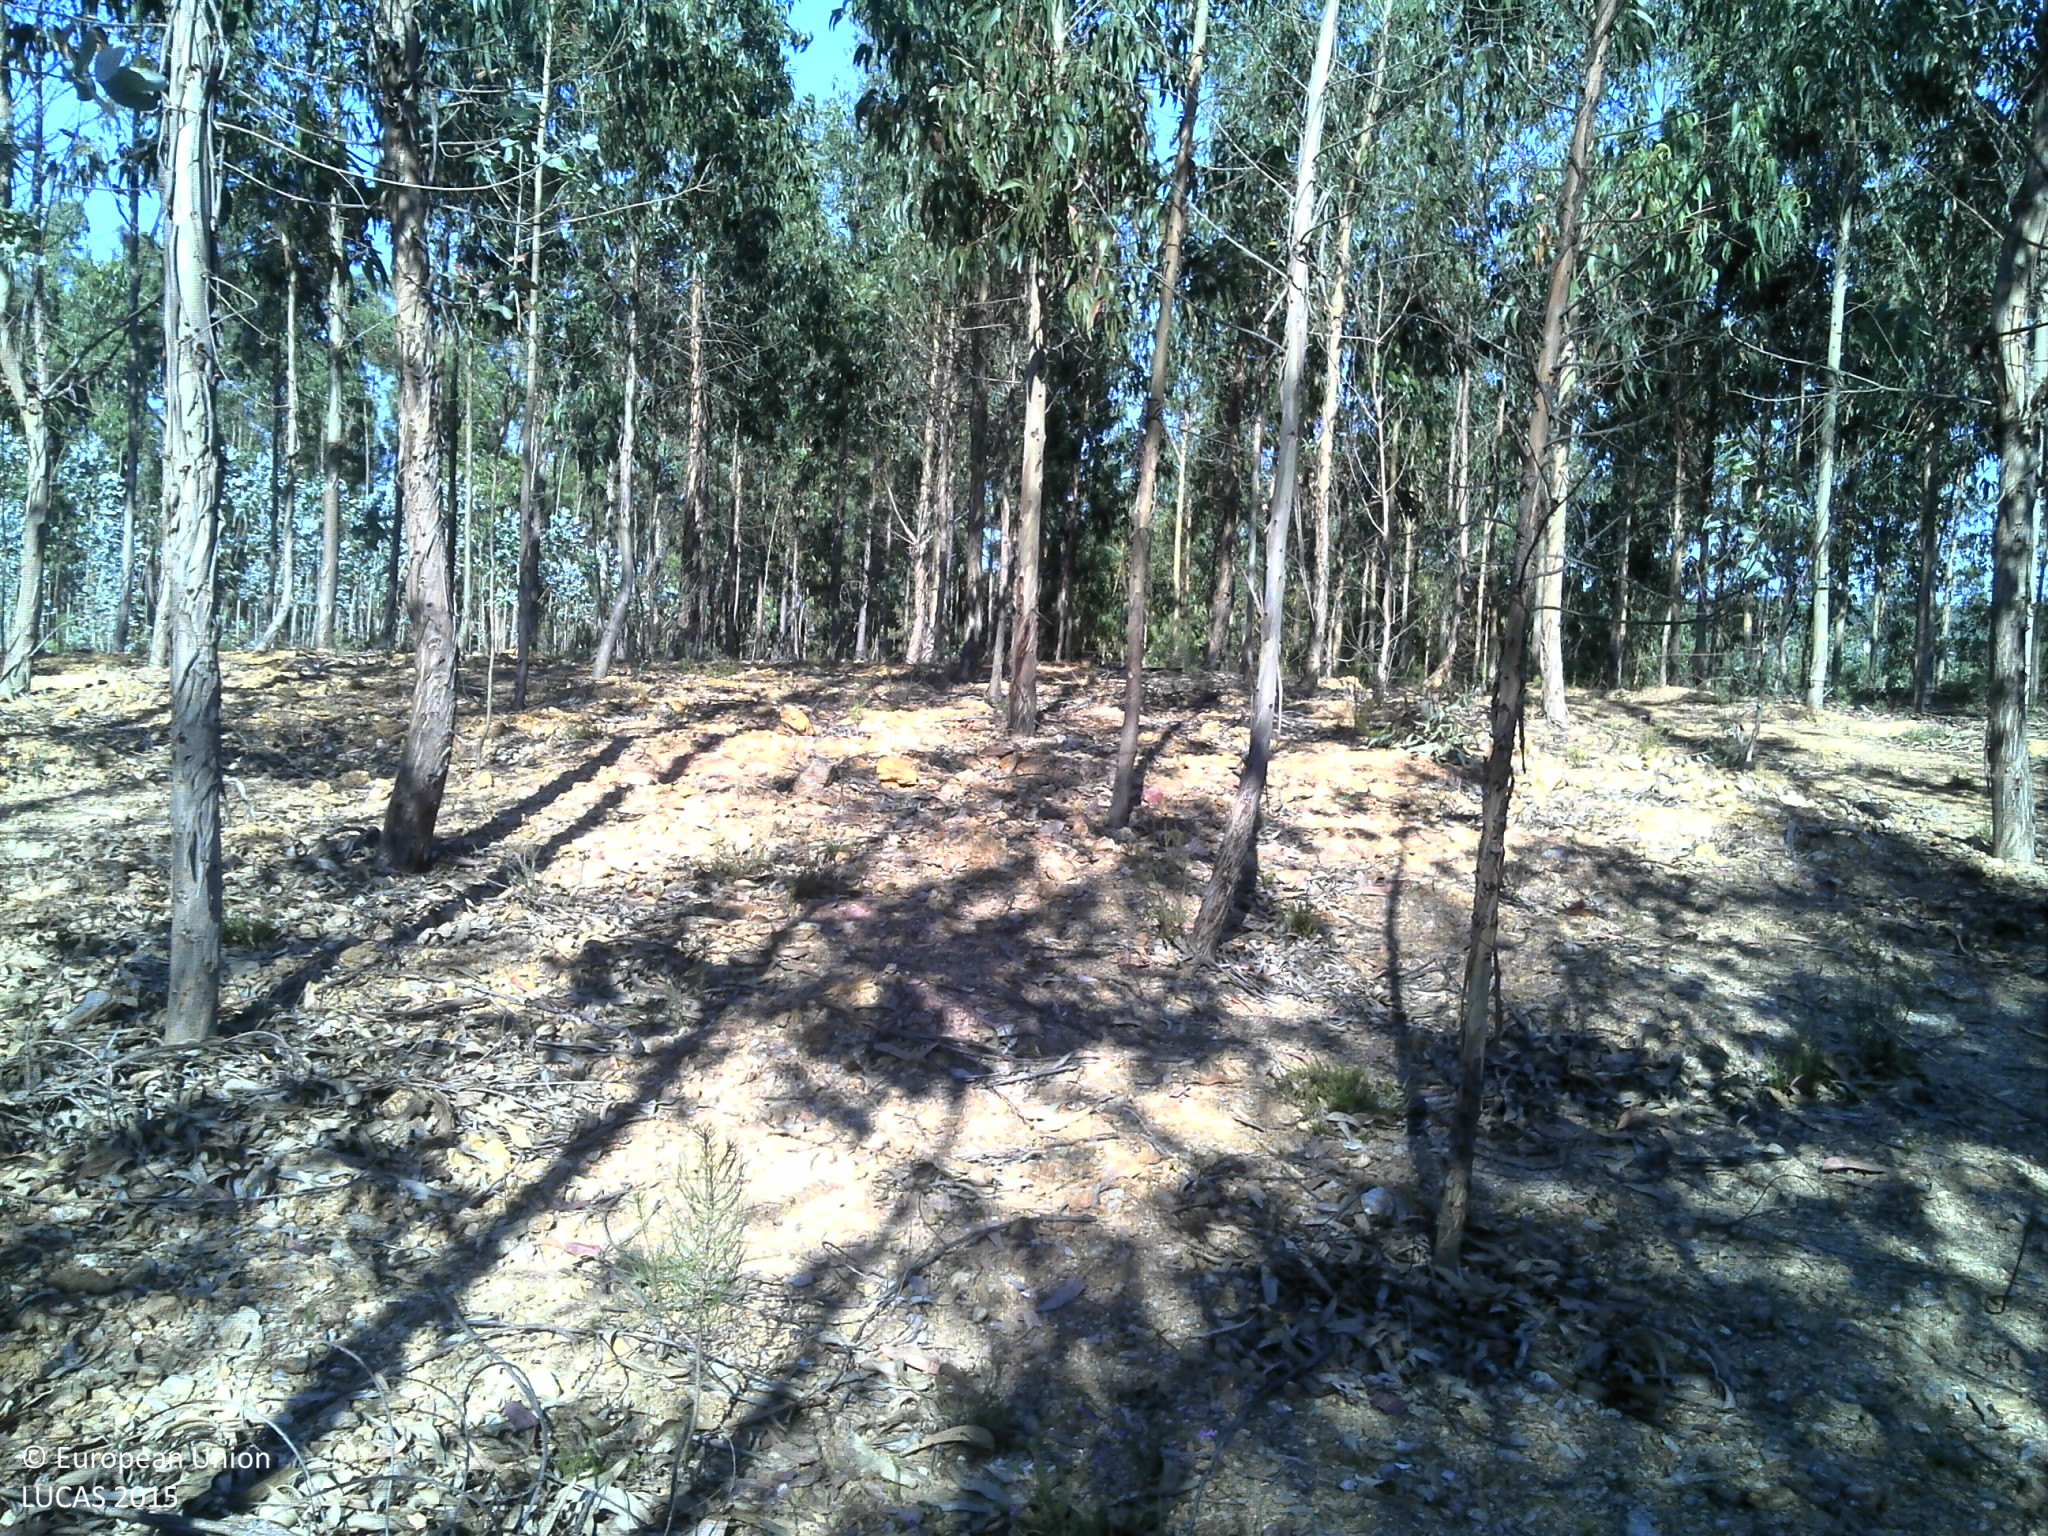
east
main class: Woodland
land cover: Broadleaved woodland
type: exotic forest
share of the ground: 50 - 75 %
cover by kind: broadleaved forest trees 60 %, unconsolidated bare surface 35 %, shrubs 5 %
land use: Forestry
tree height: > 5 m
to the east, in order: Broadleaved woodland; Tracks; Broadleaved woodland; Ditches and canals; Broadleaved woodland; Pine dominated mixed woodland
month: June
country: PT
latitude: 40.6839
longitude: -8.4439
